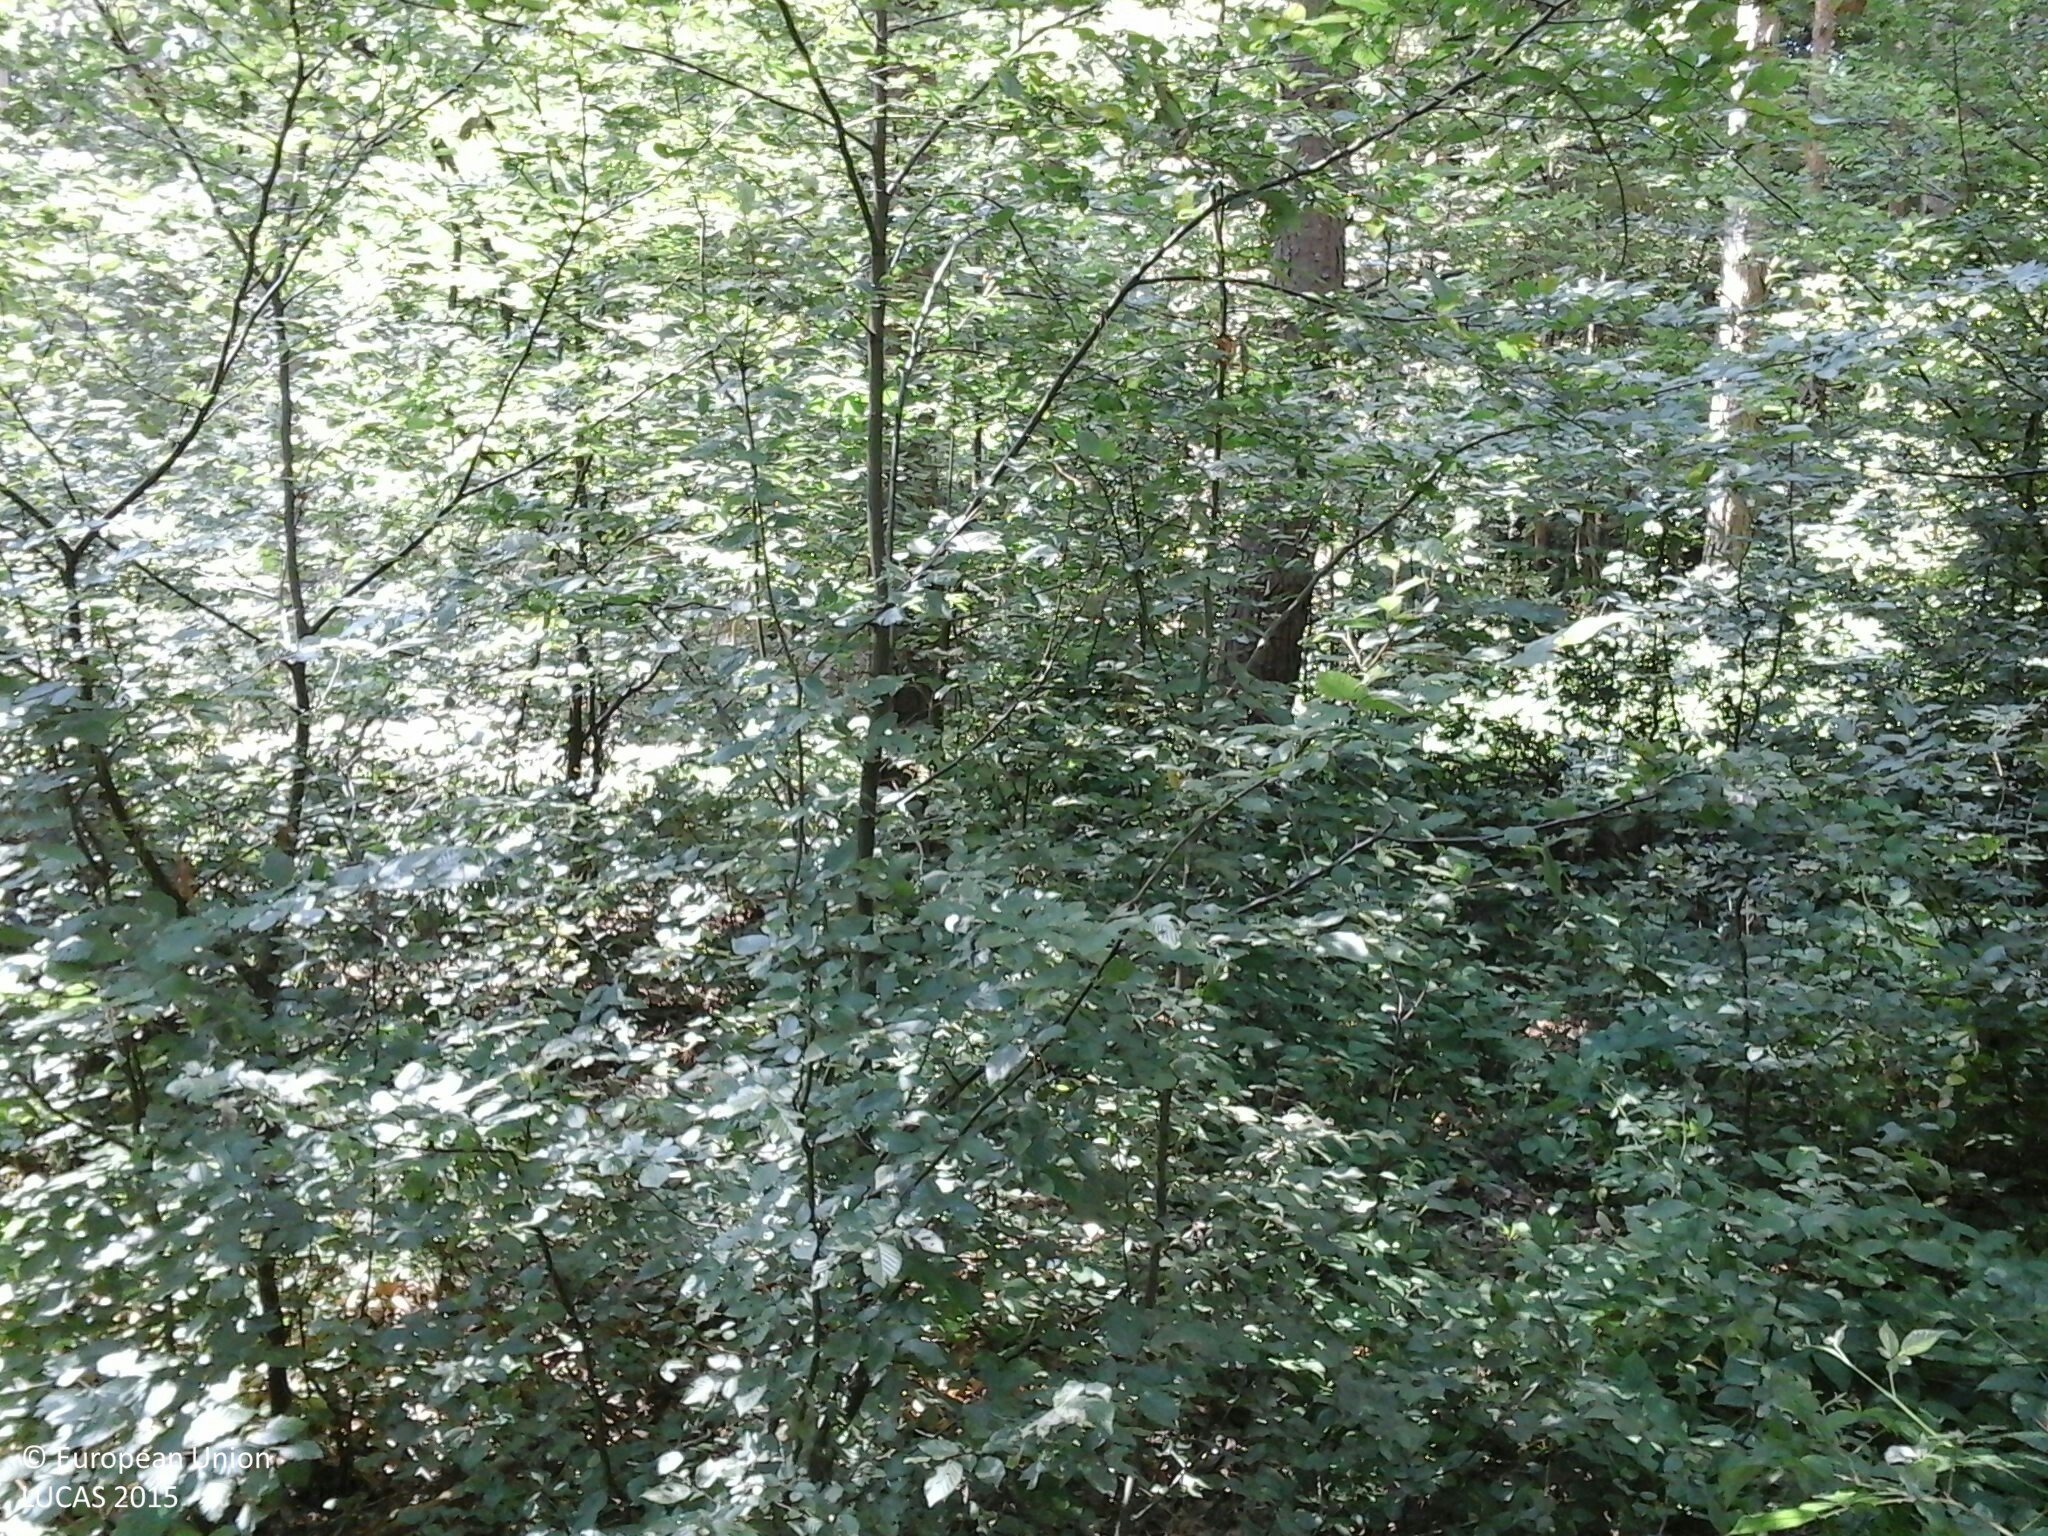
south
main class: Woodland
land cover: Other mixed woodland
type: hemiboreal forest and nemoral coniferous forest and mixed broadleaved-coniferous forest
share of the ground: > 75 %
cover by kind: coniferous forest trees 60 %, broadleaved forest trees 20 %, shrubs 15 %, herbaceous plants 5 %
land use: Forestry
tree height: > 5 m
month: July
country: HU
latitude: 46.9260
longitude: 16.2660
